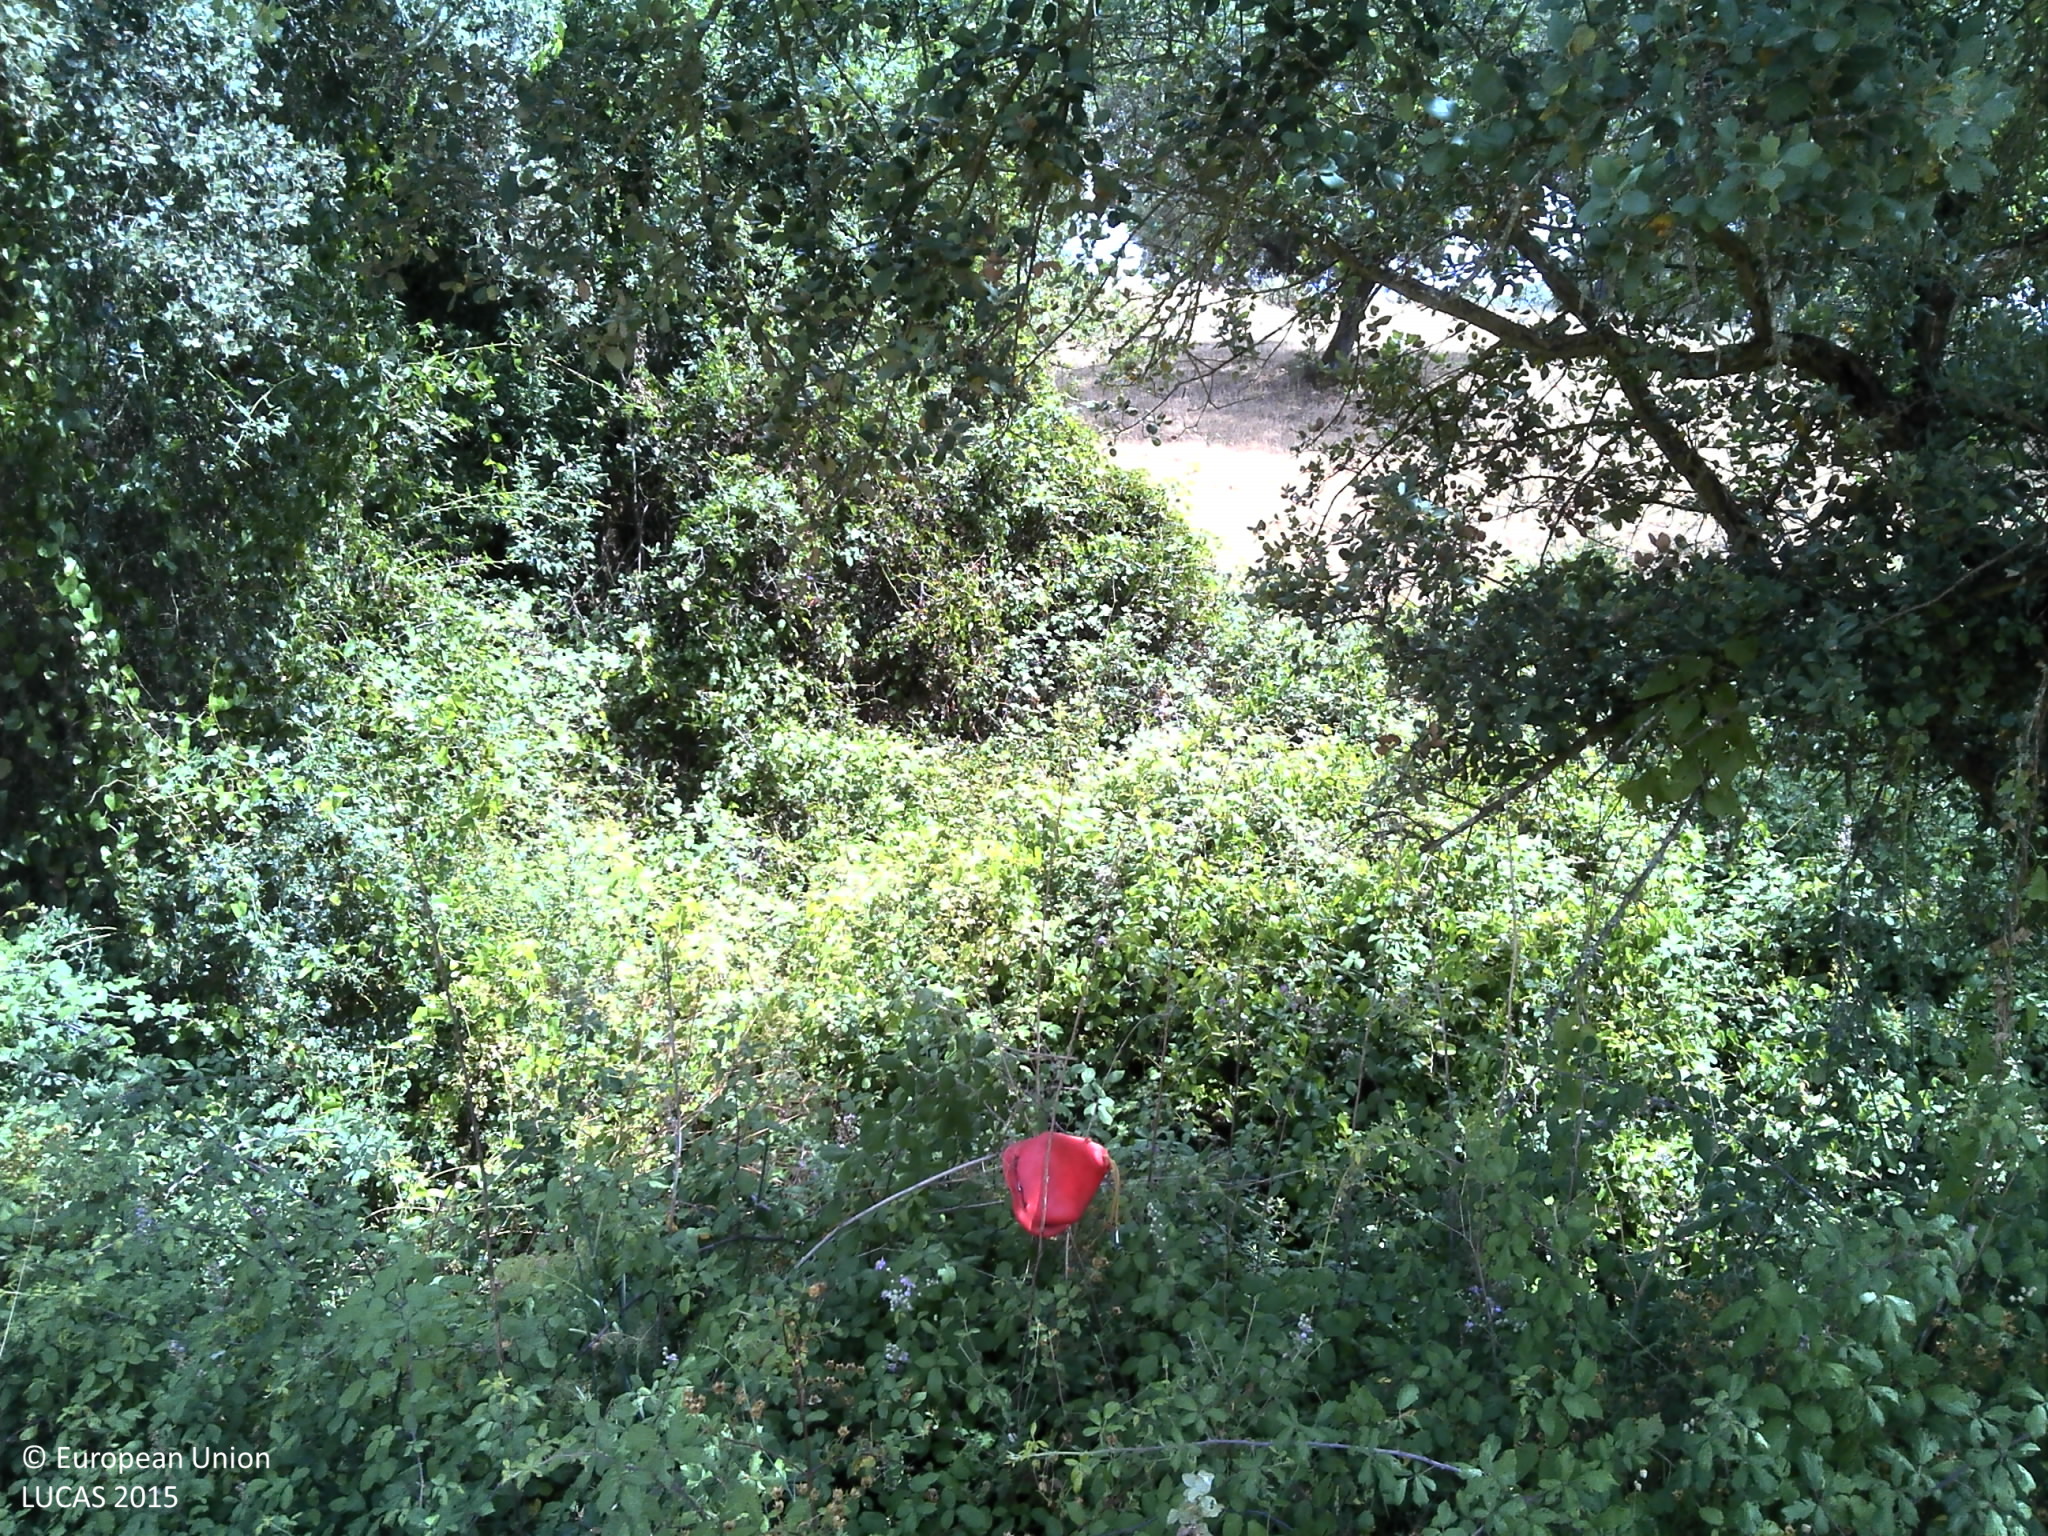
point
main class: Woodland
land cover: Broadleaved woodland
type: broadleaved evergreen forest
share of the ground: 10 - 25 %
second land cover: Shrubland without tree cover
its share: 50 - 75 %
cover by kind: shrubs 50 %, broadleaved forest trees 25 %, unconsolidated bare surface 20 %, herbaceous plants 5 %
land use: Forestry
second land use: Agriculture (excluding fallow land and kitchen gardens)
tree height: > 5 m
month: June
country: PT
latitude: 38.5507
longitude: -8.0930
